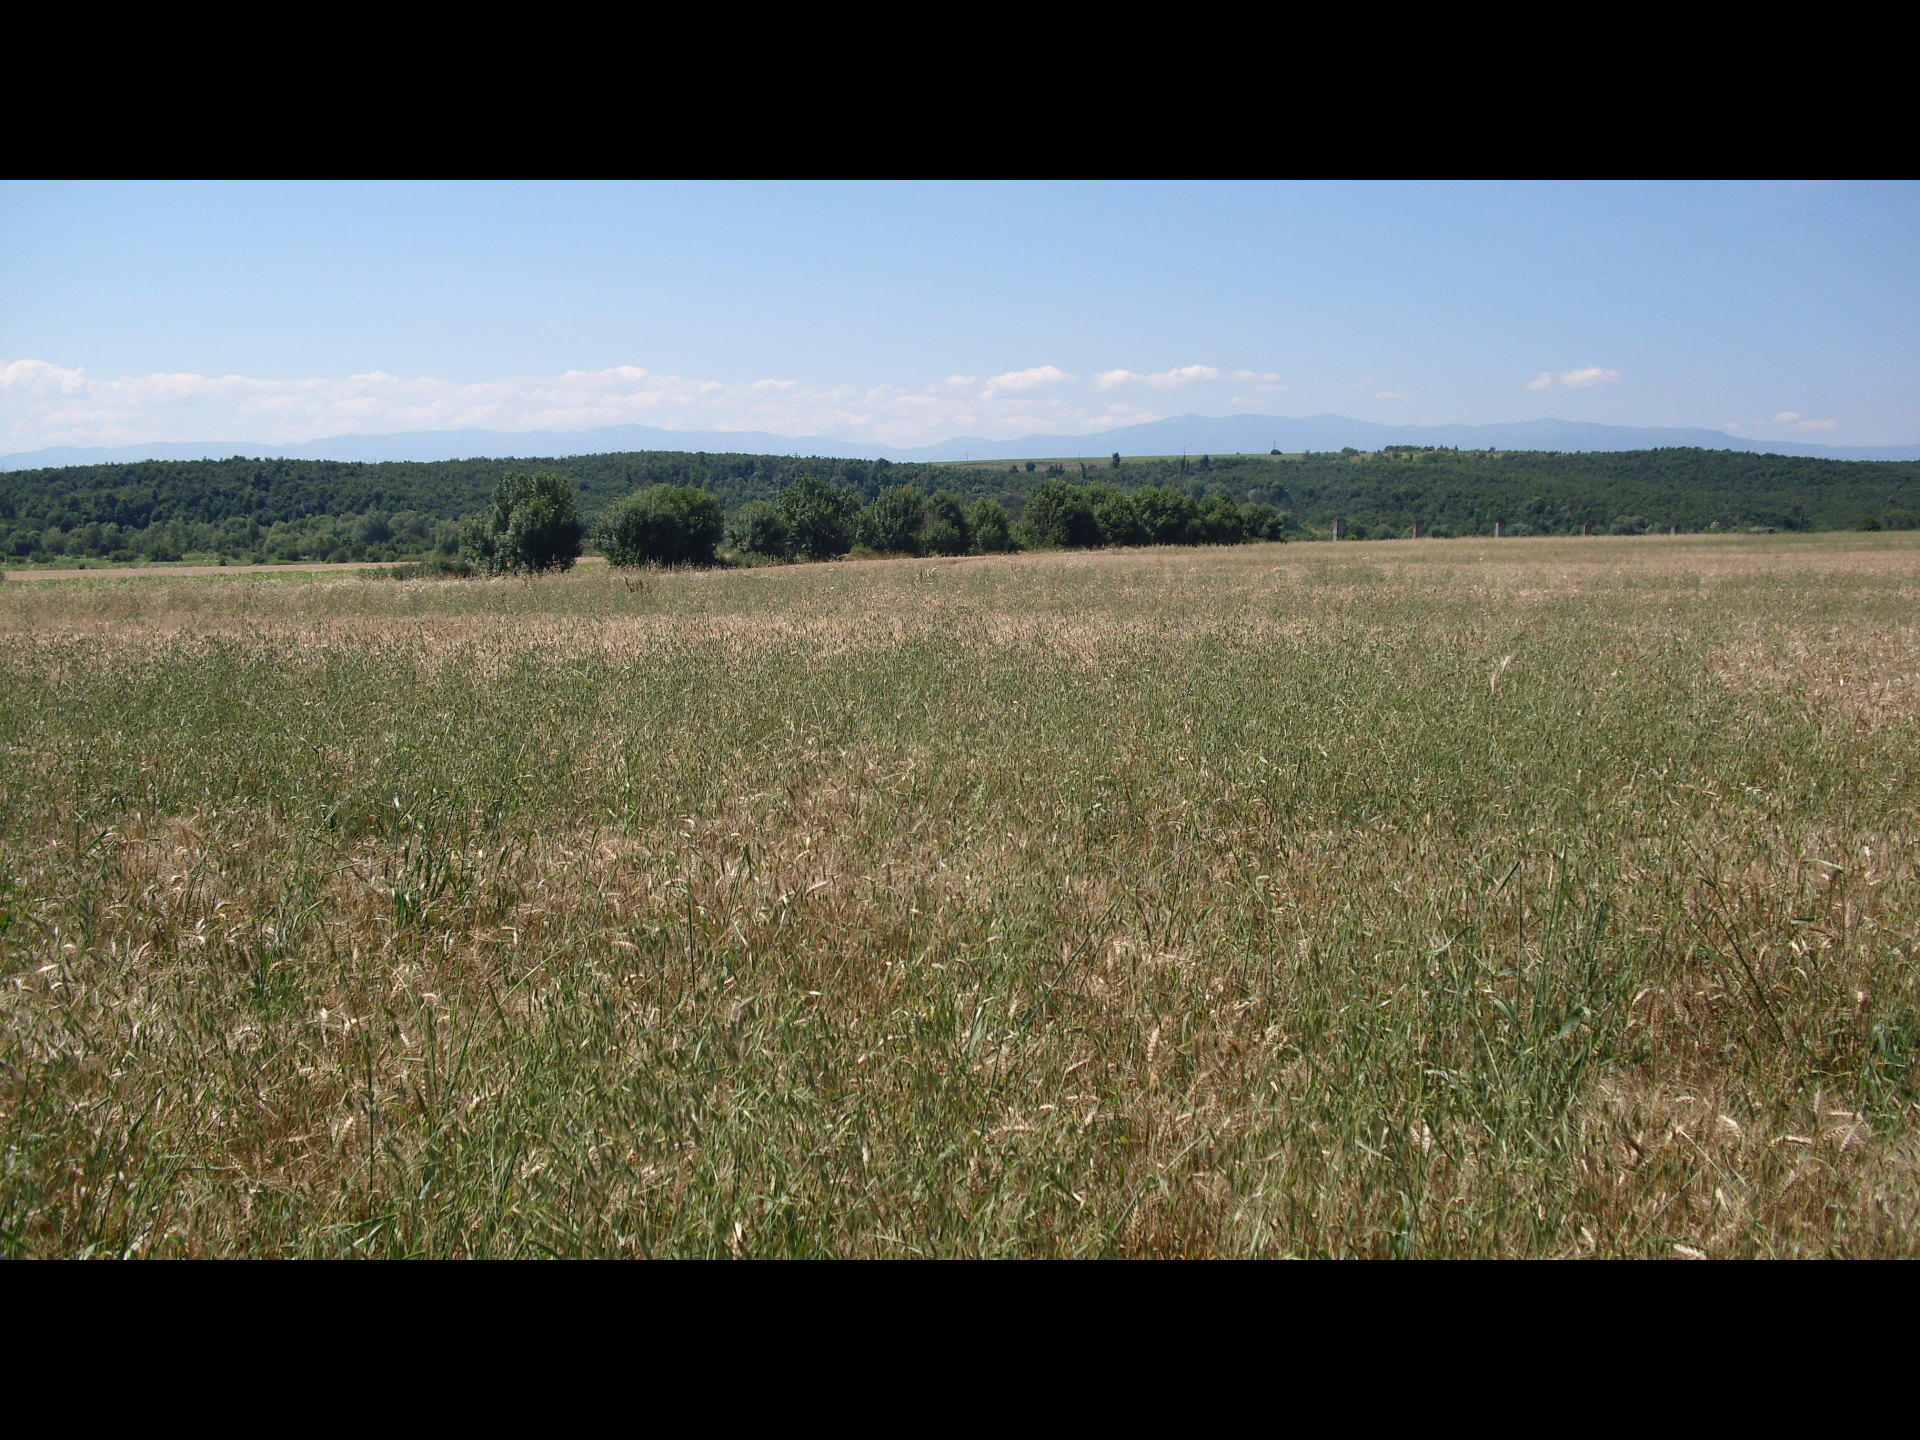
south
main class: Cropland
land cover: Common wheat
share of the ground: > 75 %
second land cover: Oats
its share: 10 - 25 %
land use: Agriculture (excluding fallow land and kitchen gardens)
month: June
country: BG
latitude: 43.4629
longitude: 23.2282
